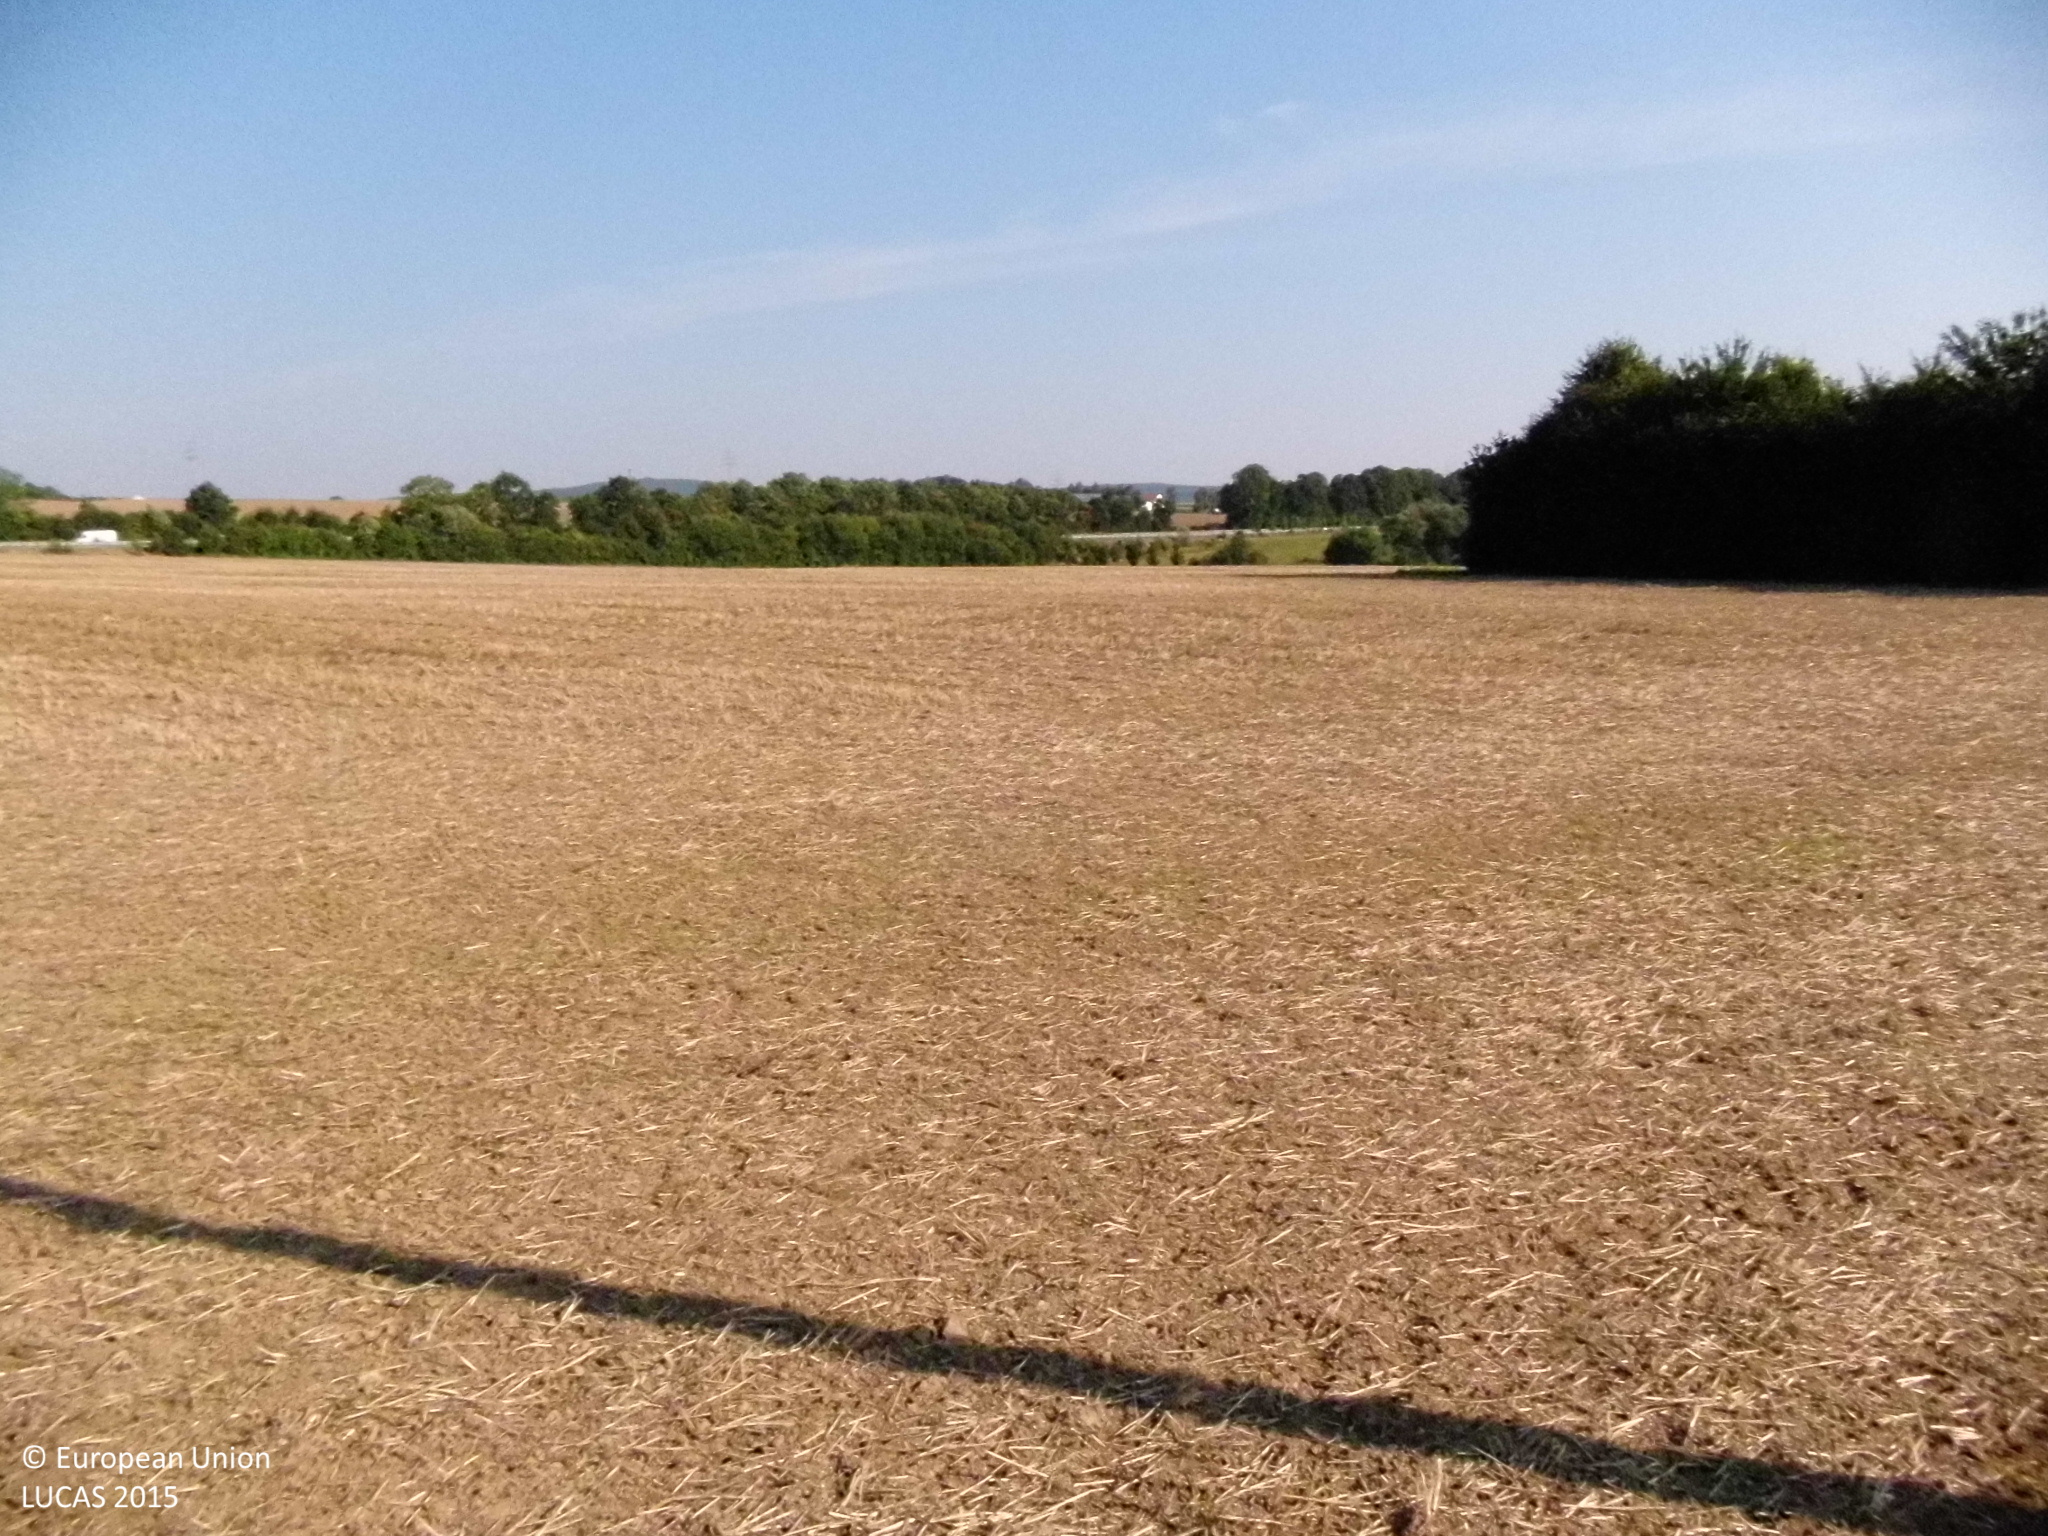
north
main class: Cropland
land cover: Common wheat
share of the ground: < 10 %
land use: Agriculture (excluding fallow land and kitchen gardens)
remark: Tilled/Sowed
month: August
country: DE
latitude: 50.4382
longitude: 8.0996
